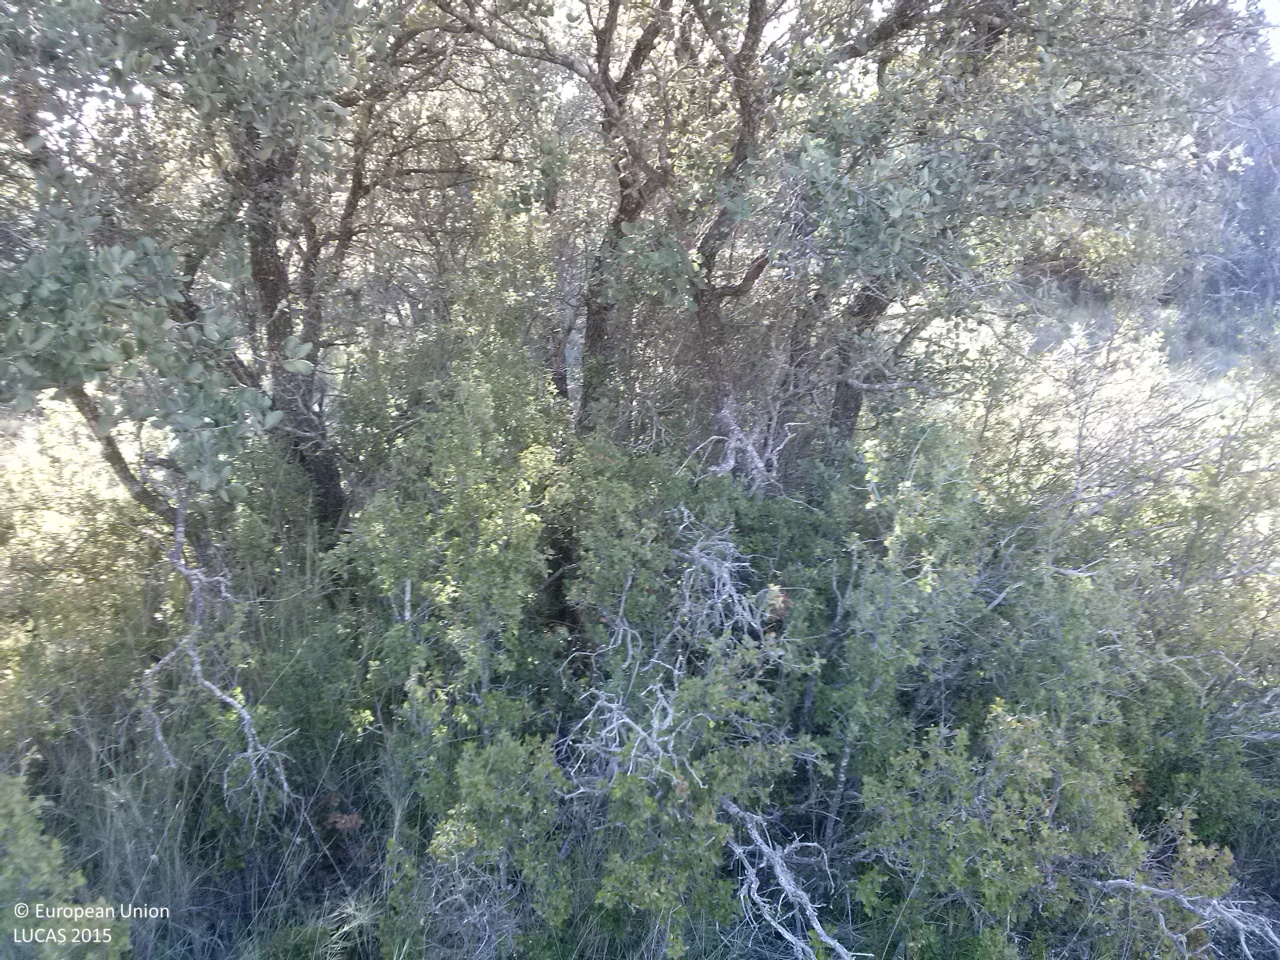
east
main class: Woodland
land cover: Broadleaved woodland
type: broadleaved evergreen forest
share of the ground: 25 - 50 %
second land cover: Grassland without tree/shrub cover
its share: 25 - 50 %
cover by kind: broadleaved forest trees 45 %, herbaceous plants 30 %, unconsolidated bare surface 20 %, shrubs 5 %
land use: Forestry
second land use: Agriculture (excluding fallow land and kitchen gardens)
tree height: < 5 m
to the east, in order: Broadleaved woodland; Grassland without tree/shrub cover; Broadleaved woodland; Tracks; Broadleaved woodland
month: May
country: ES
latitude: 39.9033
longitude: -2.7812
